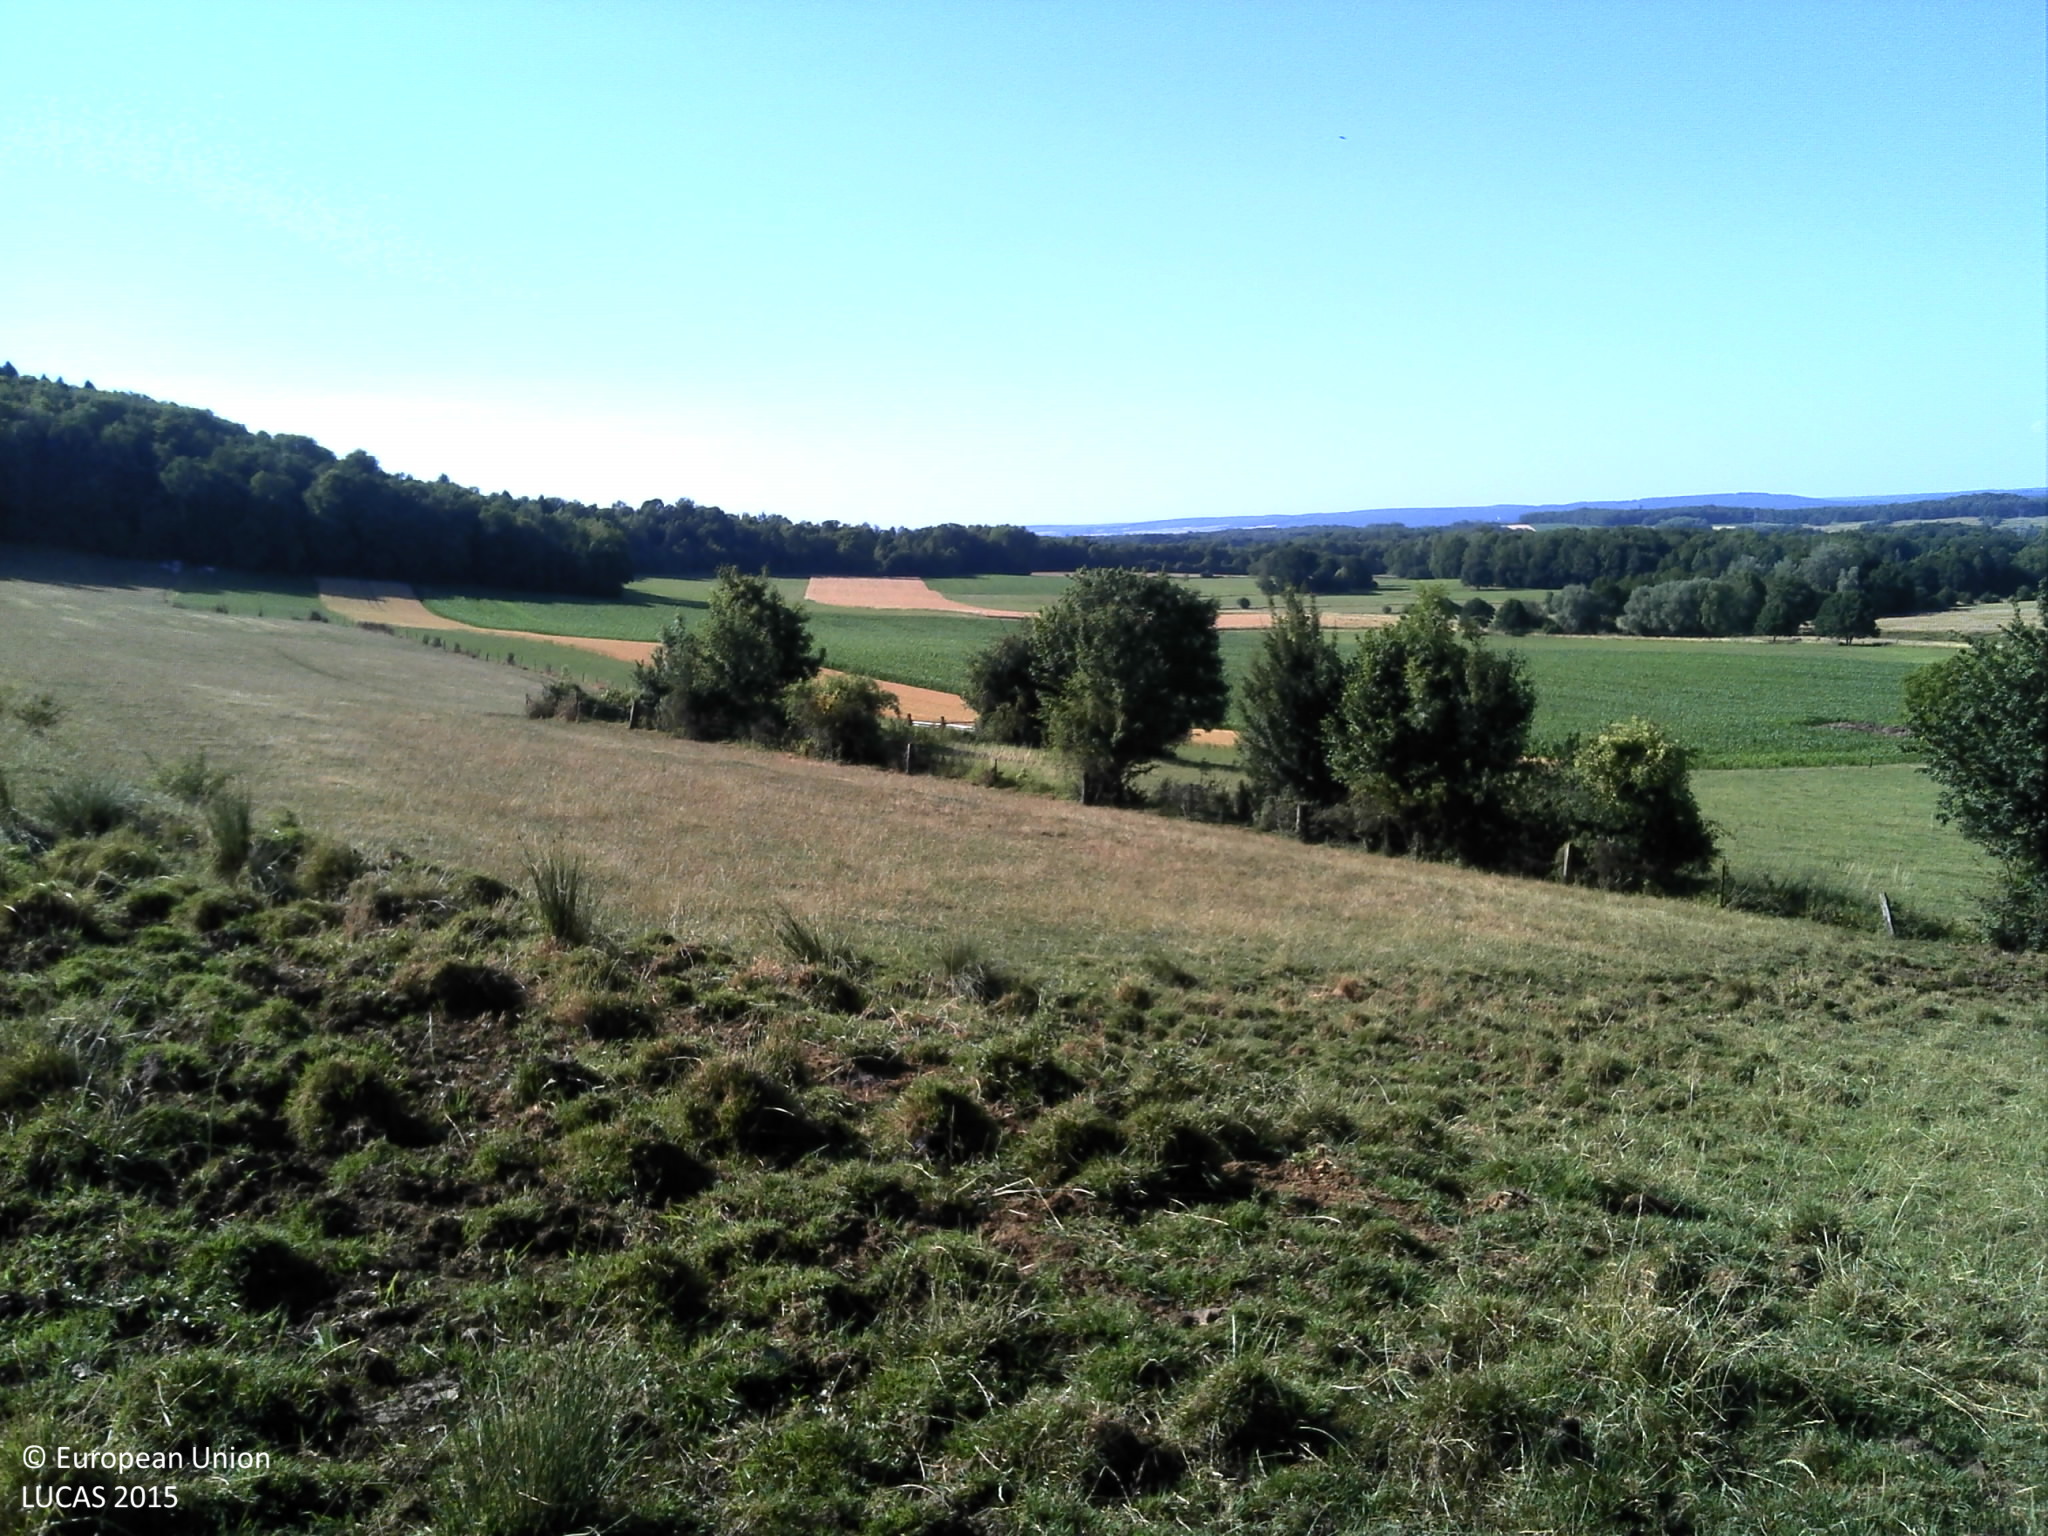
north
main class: Grassland
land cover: Grassland without tree/shrub cover
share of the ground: > 75 %
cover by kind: herbaceous plants 100 %
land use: Agriculture (excluding fallow land and kitchen gardens)
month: July
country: FR
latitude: 49.6846
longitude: 4.7437
